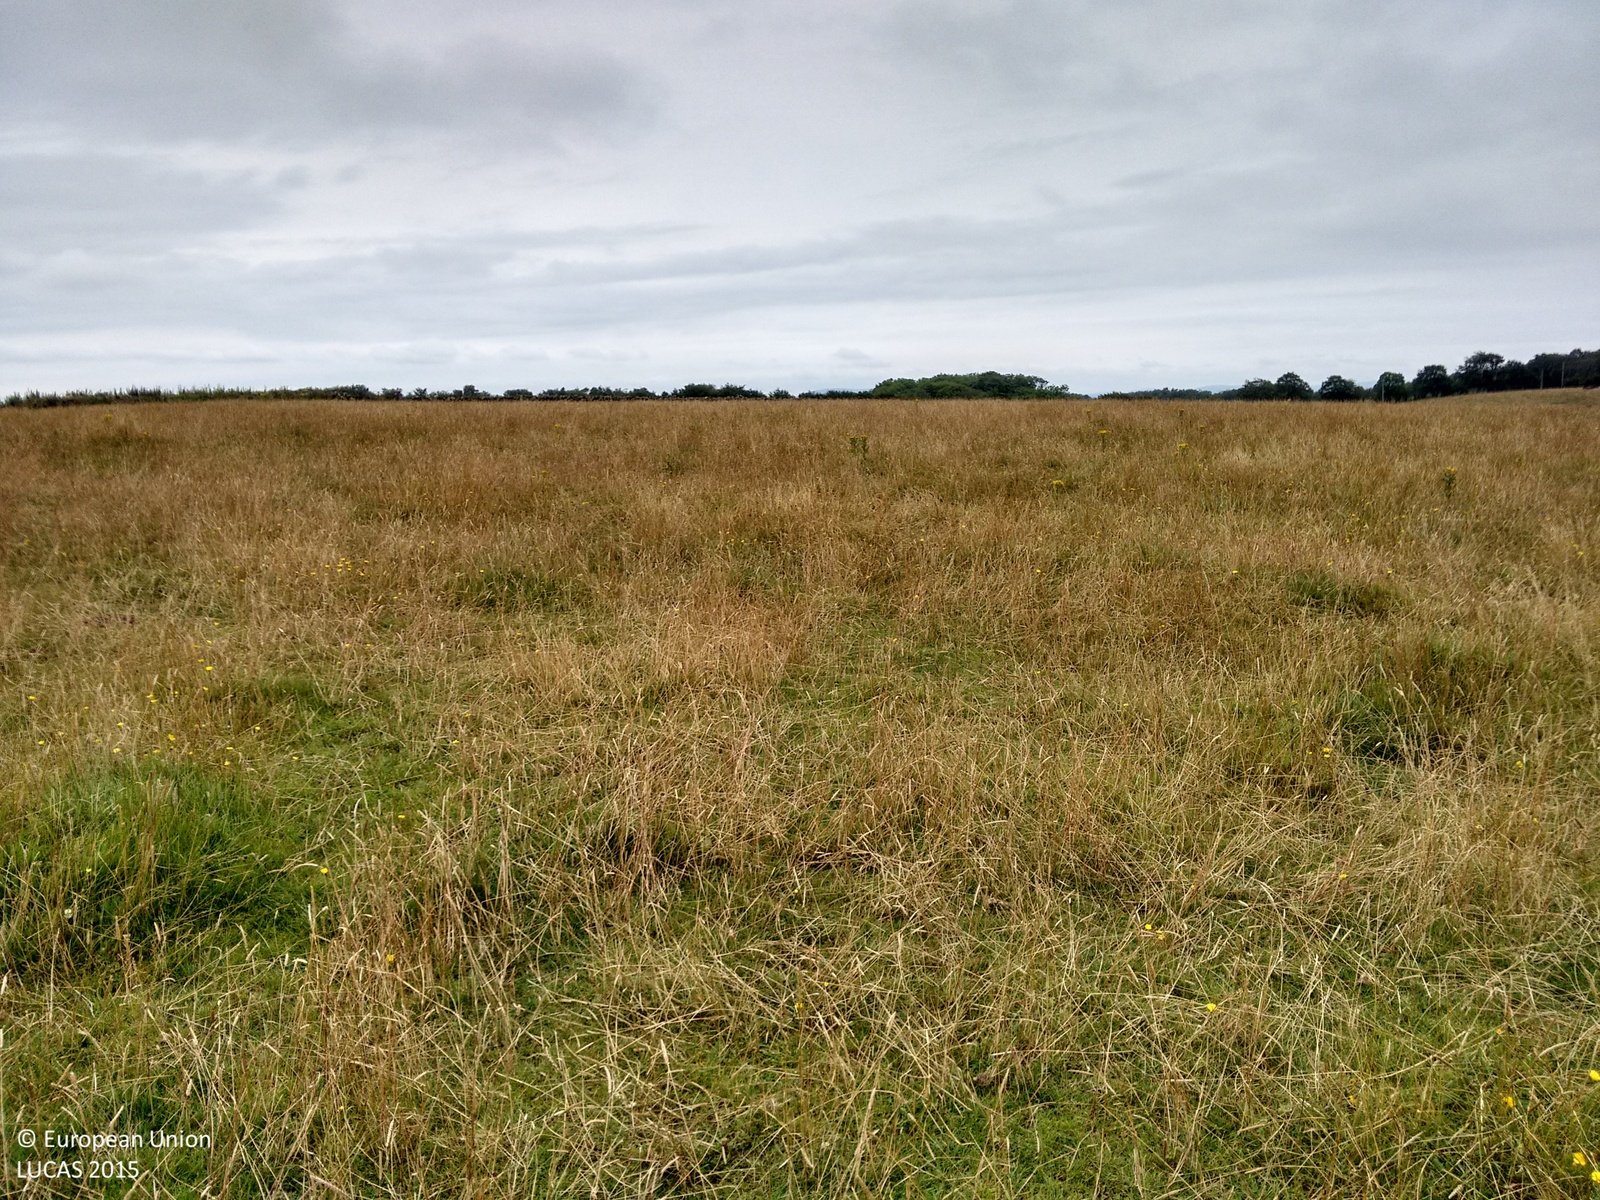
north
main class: Grassland
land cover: Grassland without tree/shrub cover
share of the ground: > 75 %
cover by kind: herbaceous plants 100 %
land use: Agriculture (excluding fallow land and kitchen gardens)
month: August
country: GB
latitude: 55.4318
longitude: -4.3355
